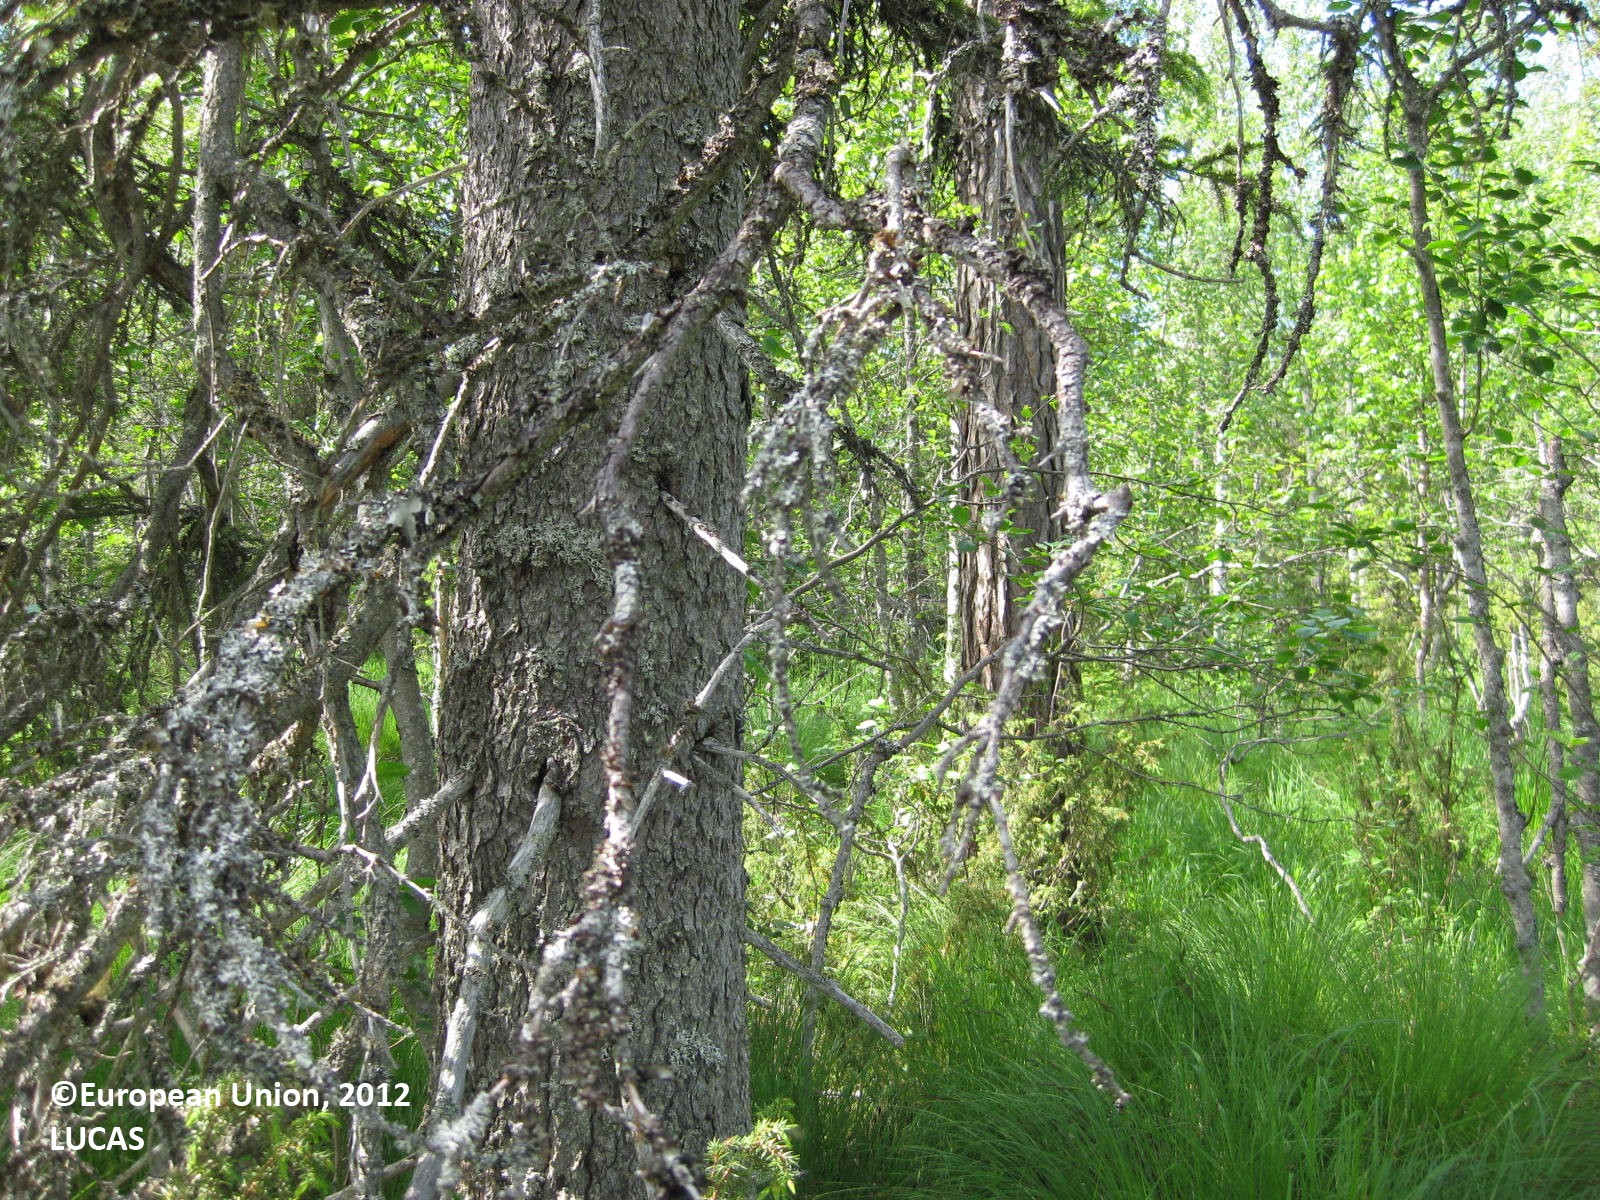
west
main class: Woodland
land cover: Pine dominated mixed woodland
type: boreal forest
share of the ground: > 75 %
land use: Semi-natural and natural areas not in use
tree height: > 5 m
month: July
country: FI
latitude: 65.5372
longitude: 29.3000
